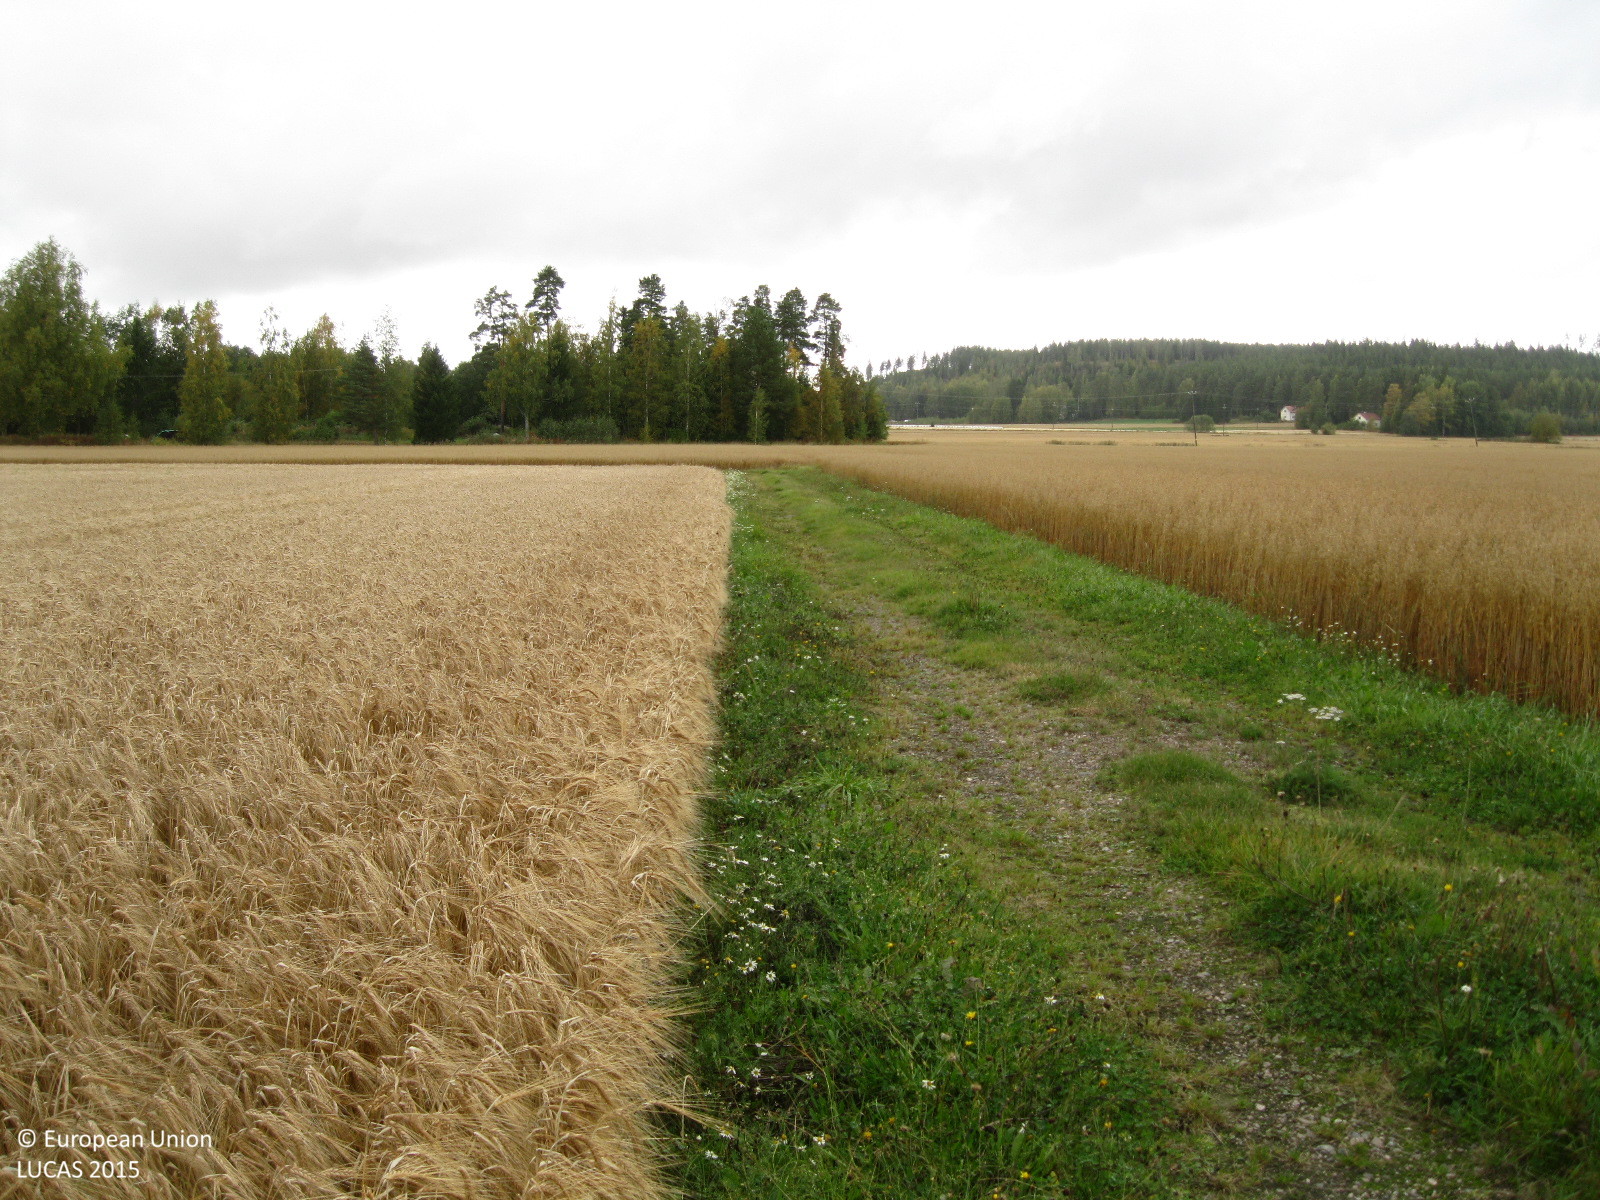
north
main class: Cropland
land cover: Barley
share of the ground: > 75 %
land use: Agriculture (excluding fallow land and kitchen gardens)
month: September
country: FI
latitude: 60.8224
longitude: 24.8404
